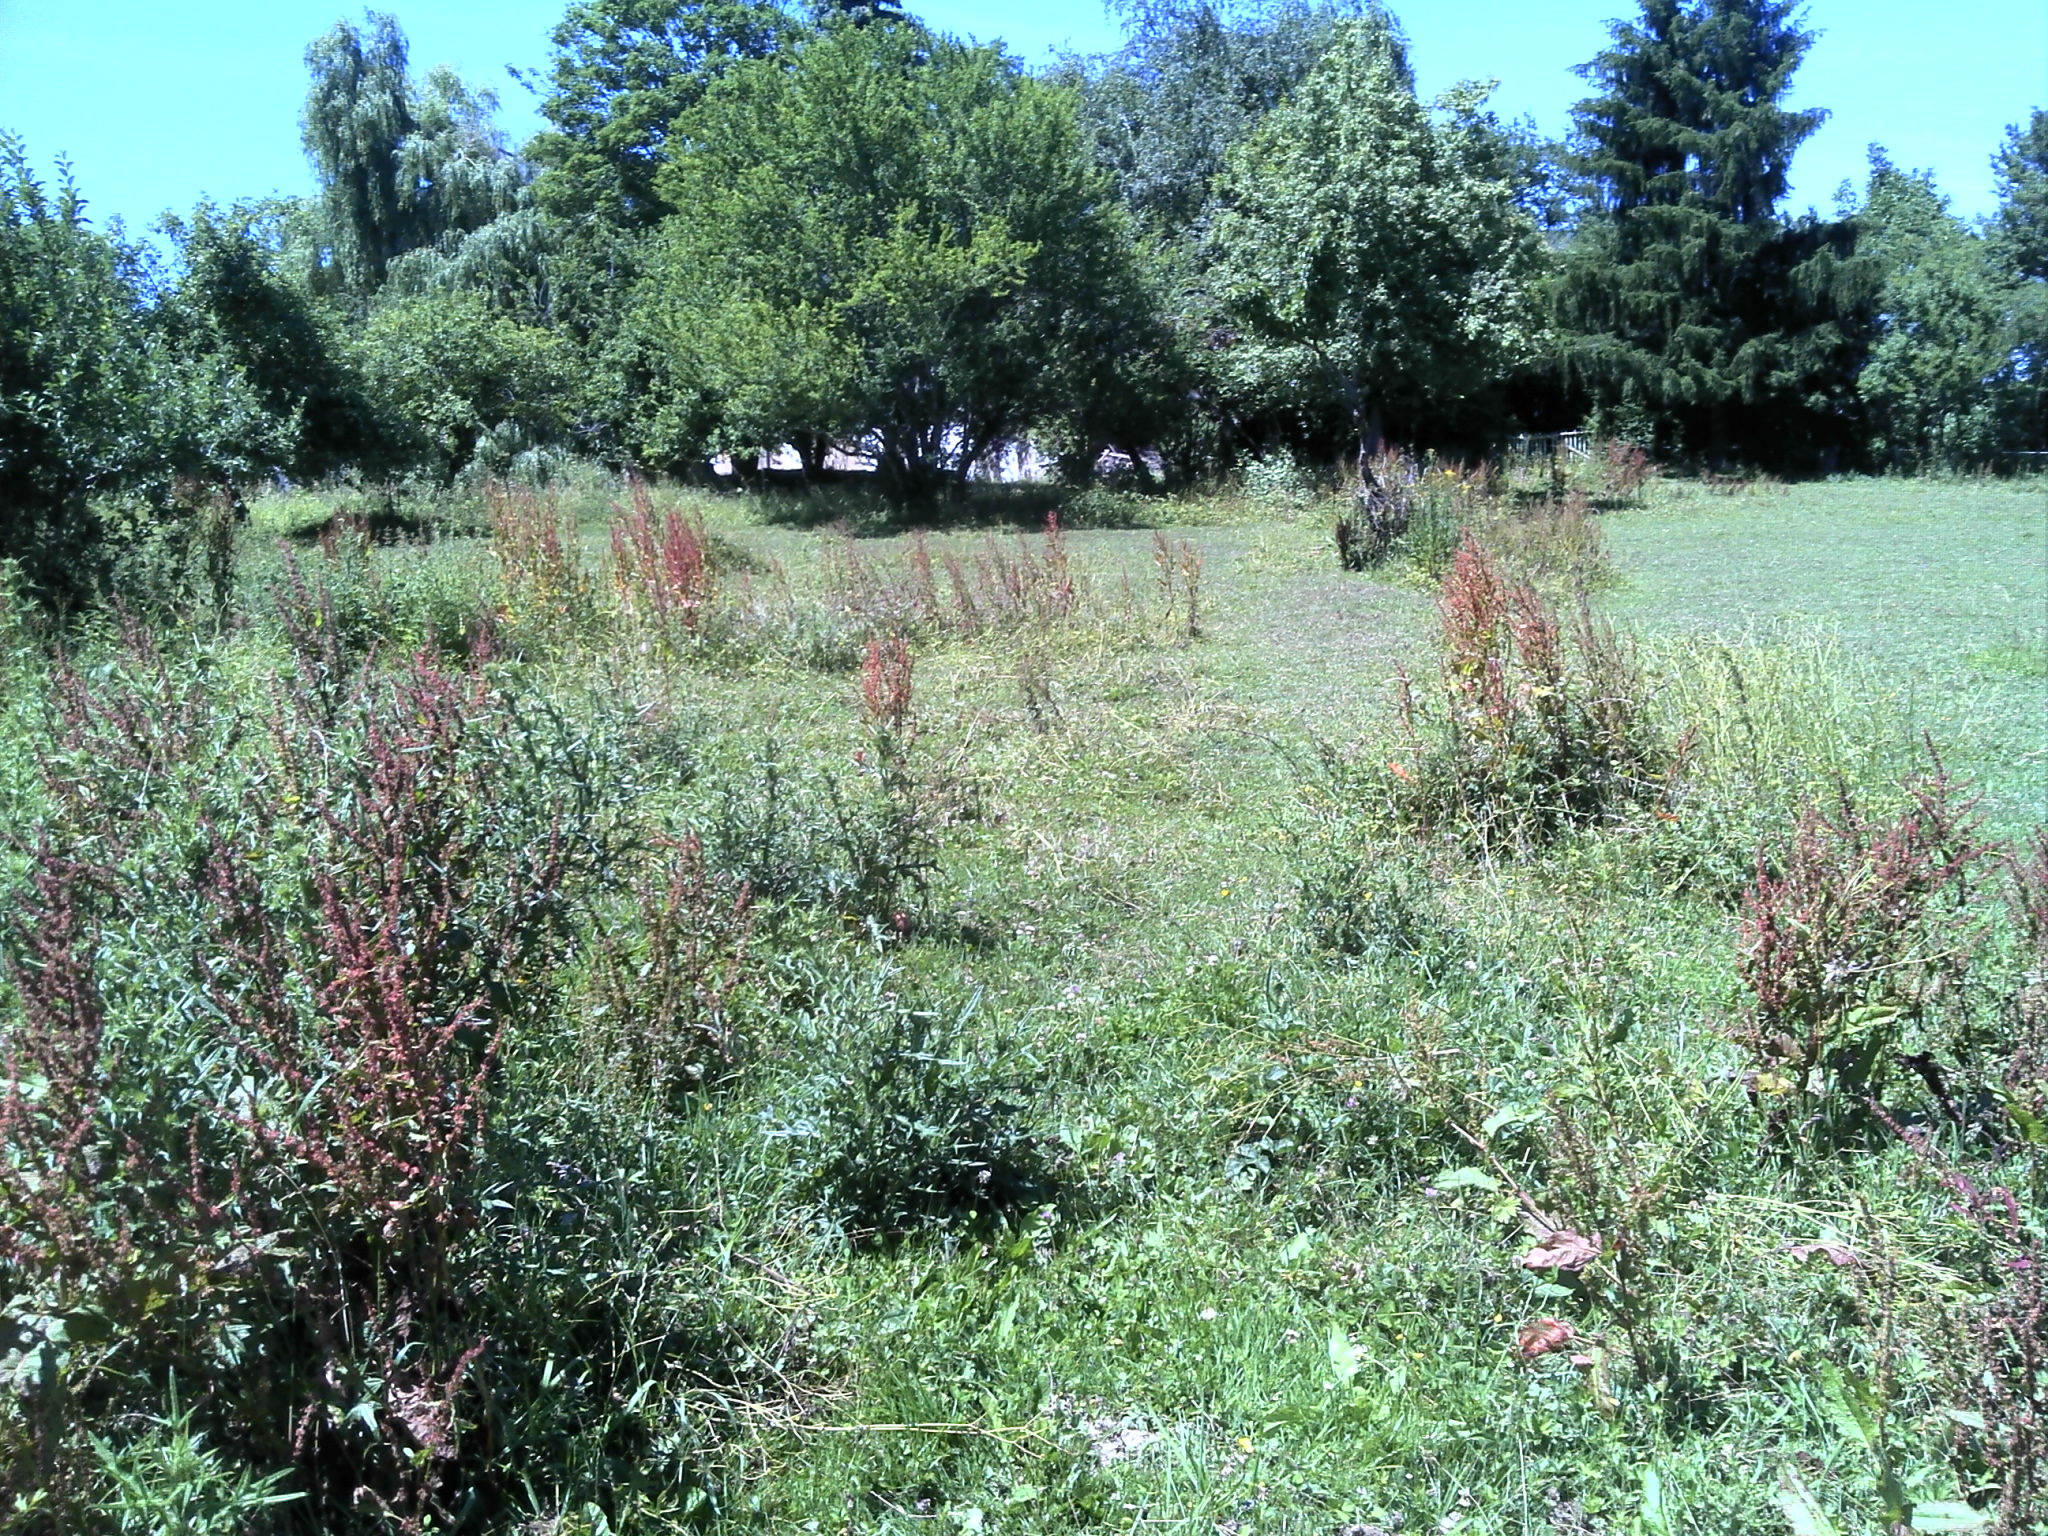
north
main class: Grassland
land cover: Grassland with sparse tree/shrub cover
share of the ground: > 75 %
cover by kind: herbaceous plants 90 %, broadleaved forest trees 5 %, shrubs 5 %
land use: Agriculture (excluding fallow land and kitchen gardens)
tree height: > 5 m
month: June
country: FR
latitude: 46.4995
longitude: 2.1885
